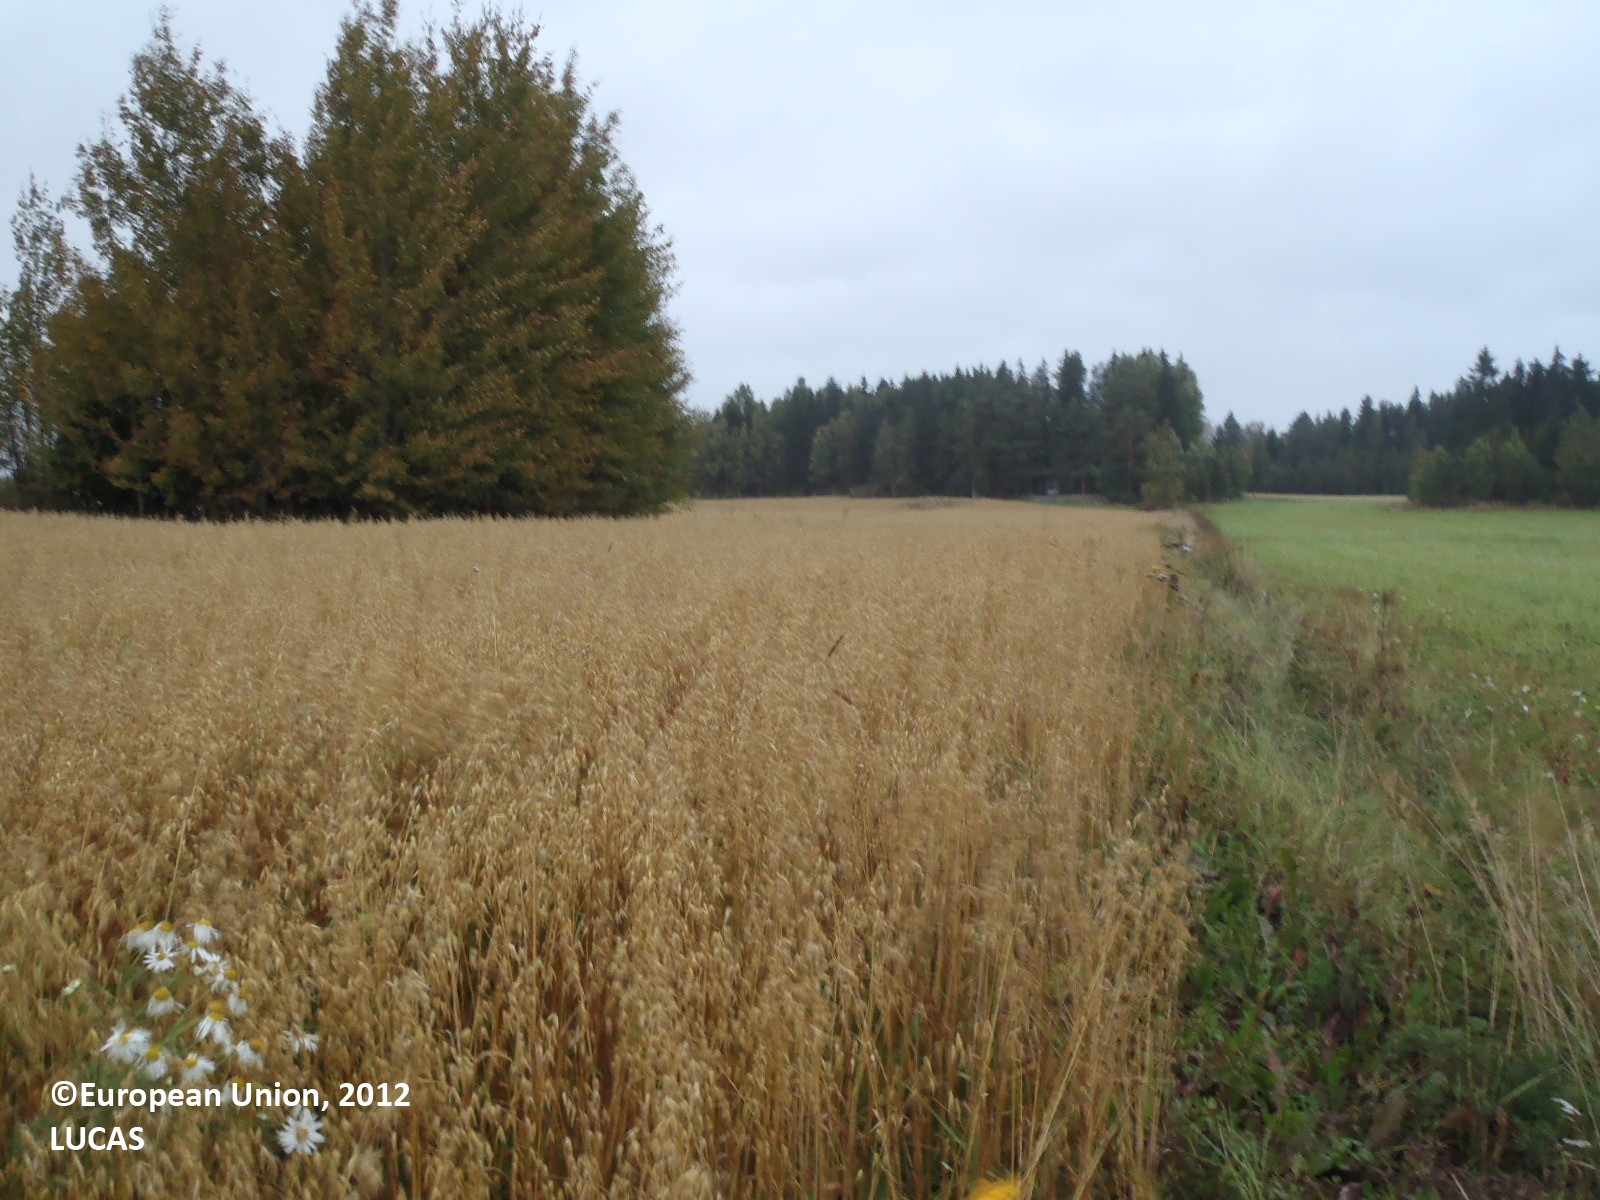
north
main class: Cropland
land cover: Oats
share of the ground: > 75 %
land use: Agriculture (excluding fallow land and kitchen gardens)
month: September
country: FI
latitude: 61.2499
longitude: 22.6855
